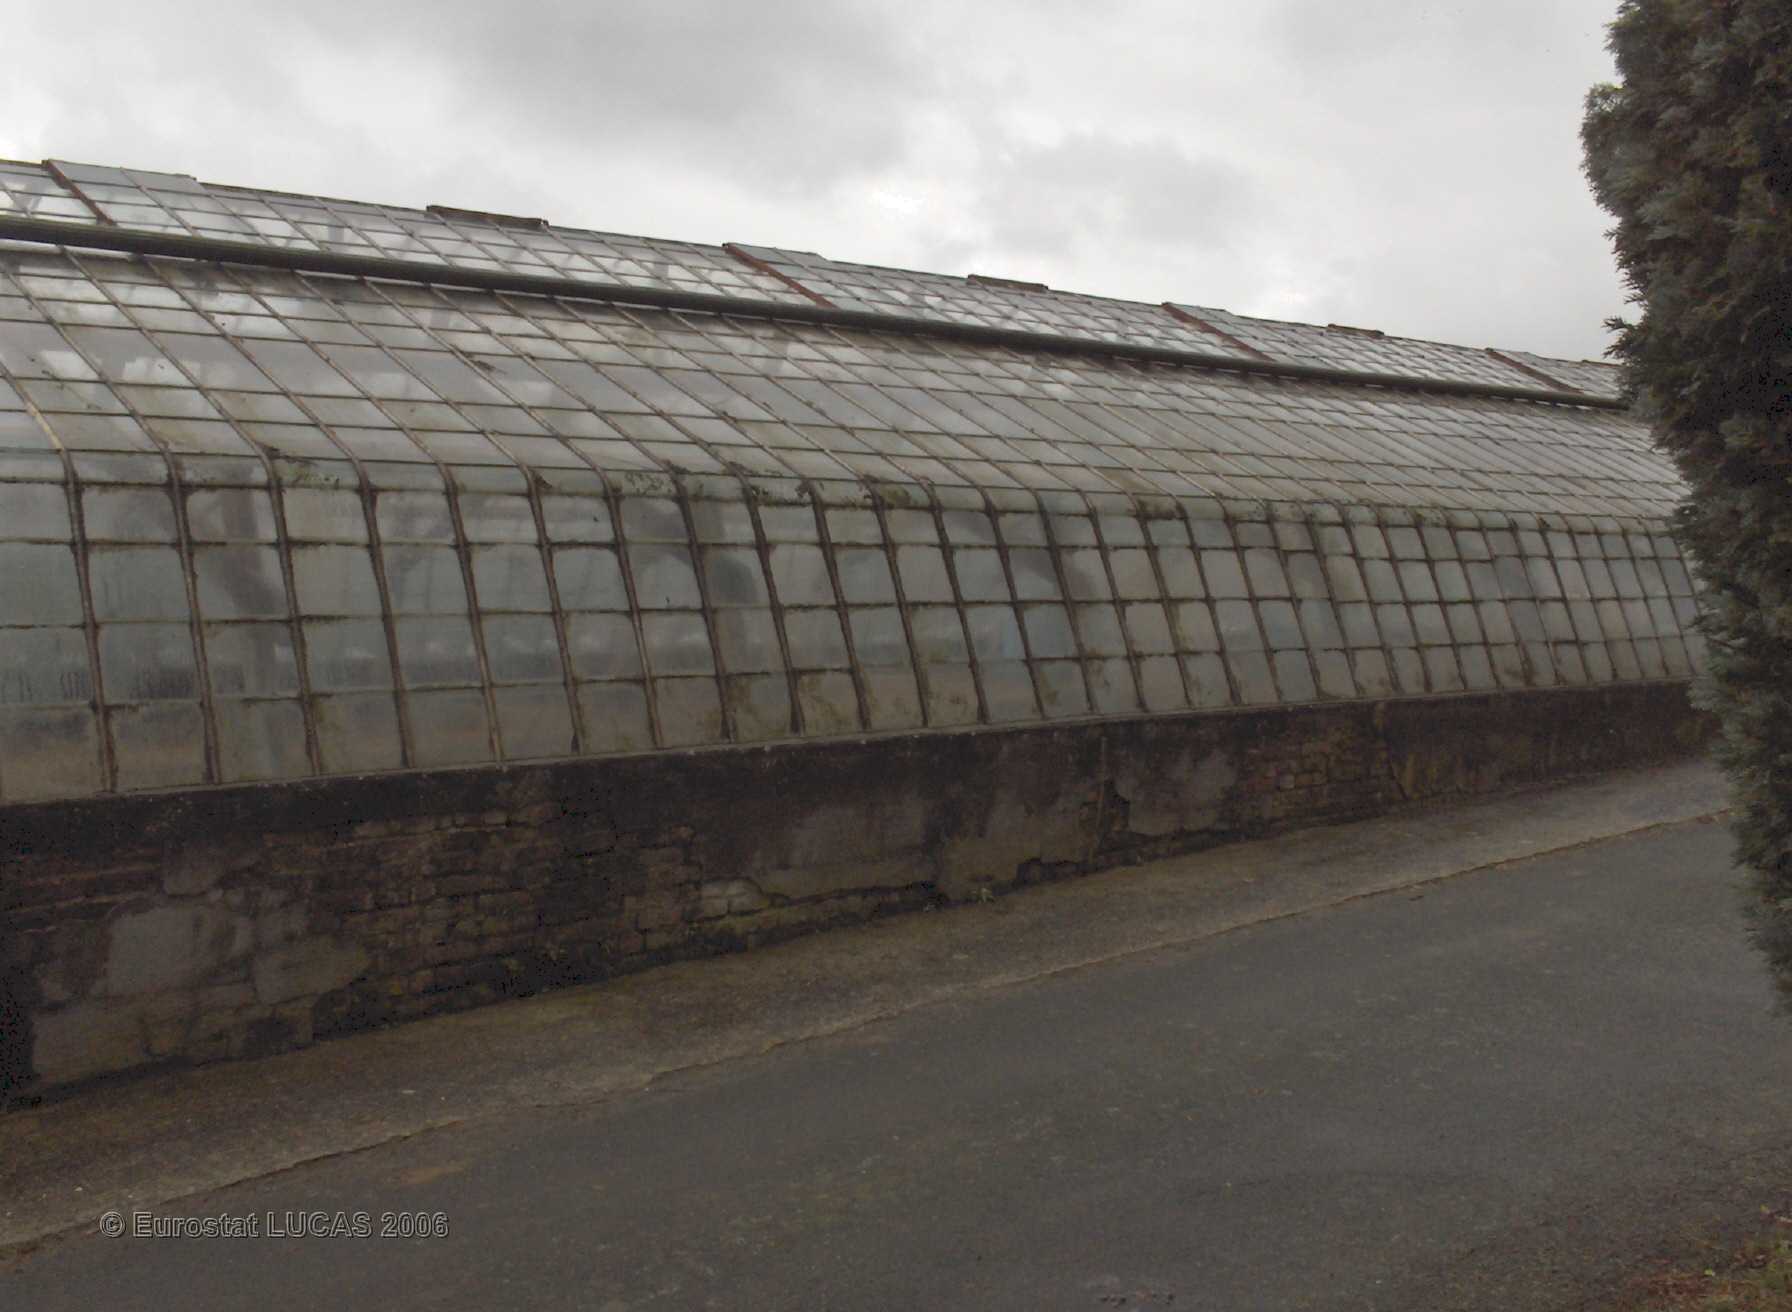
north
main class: Grassland
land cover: Grassland with sparse tree/shrub cover
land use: Residential
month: February
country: BE
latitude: 50.7742
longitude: 4.5363
